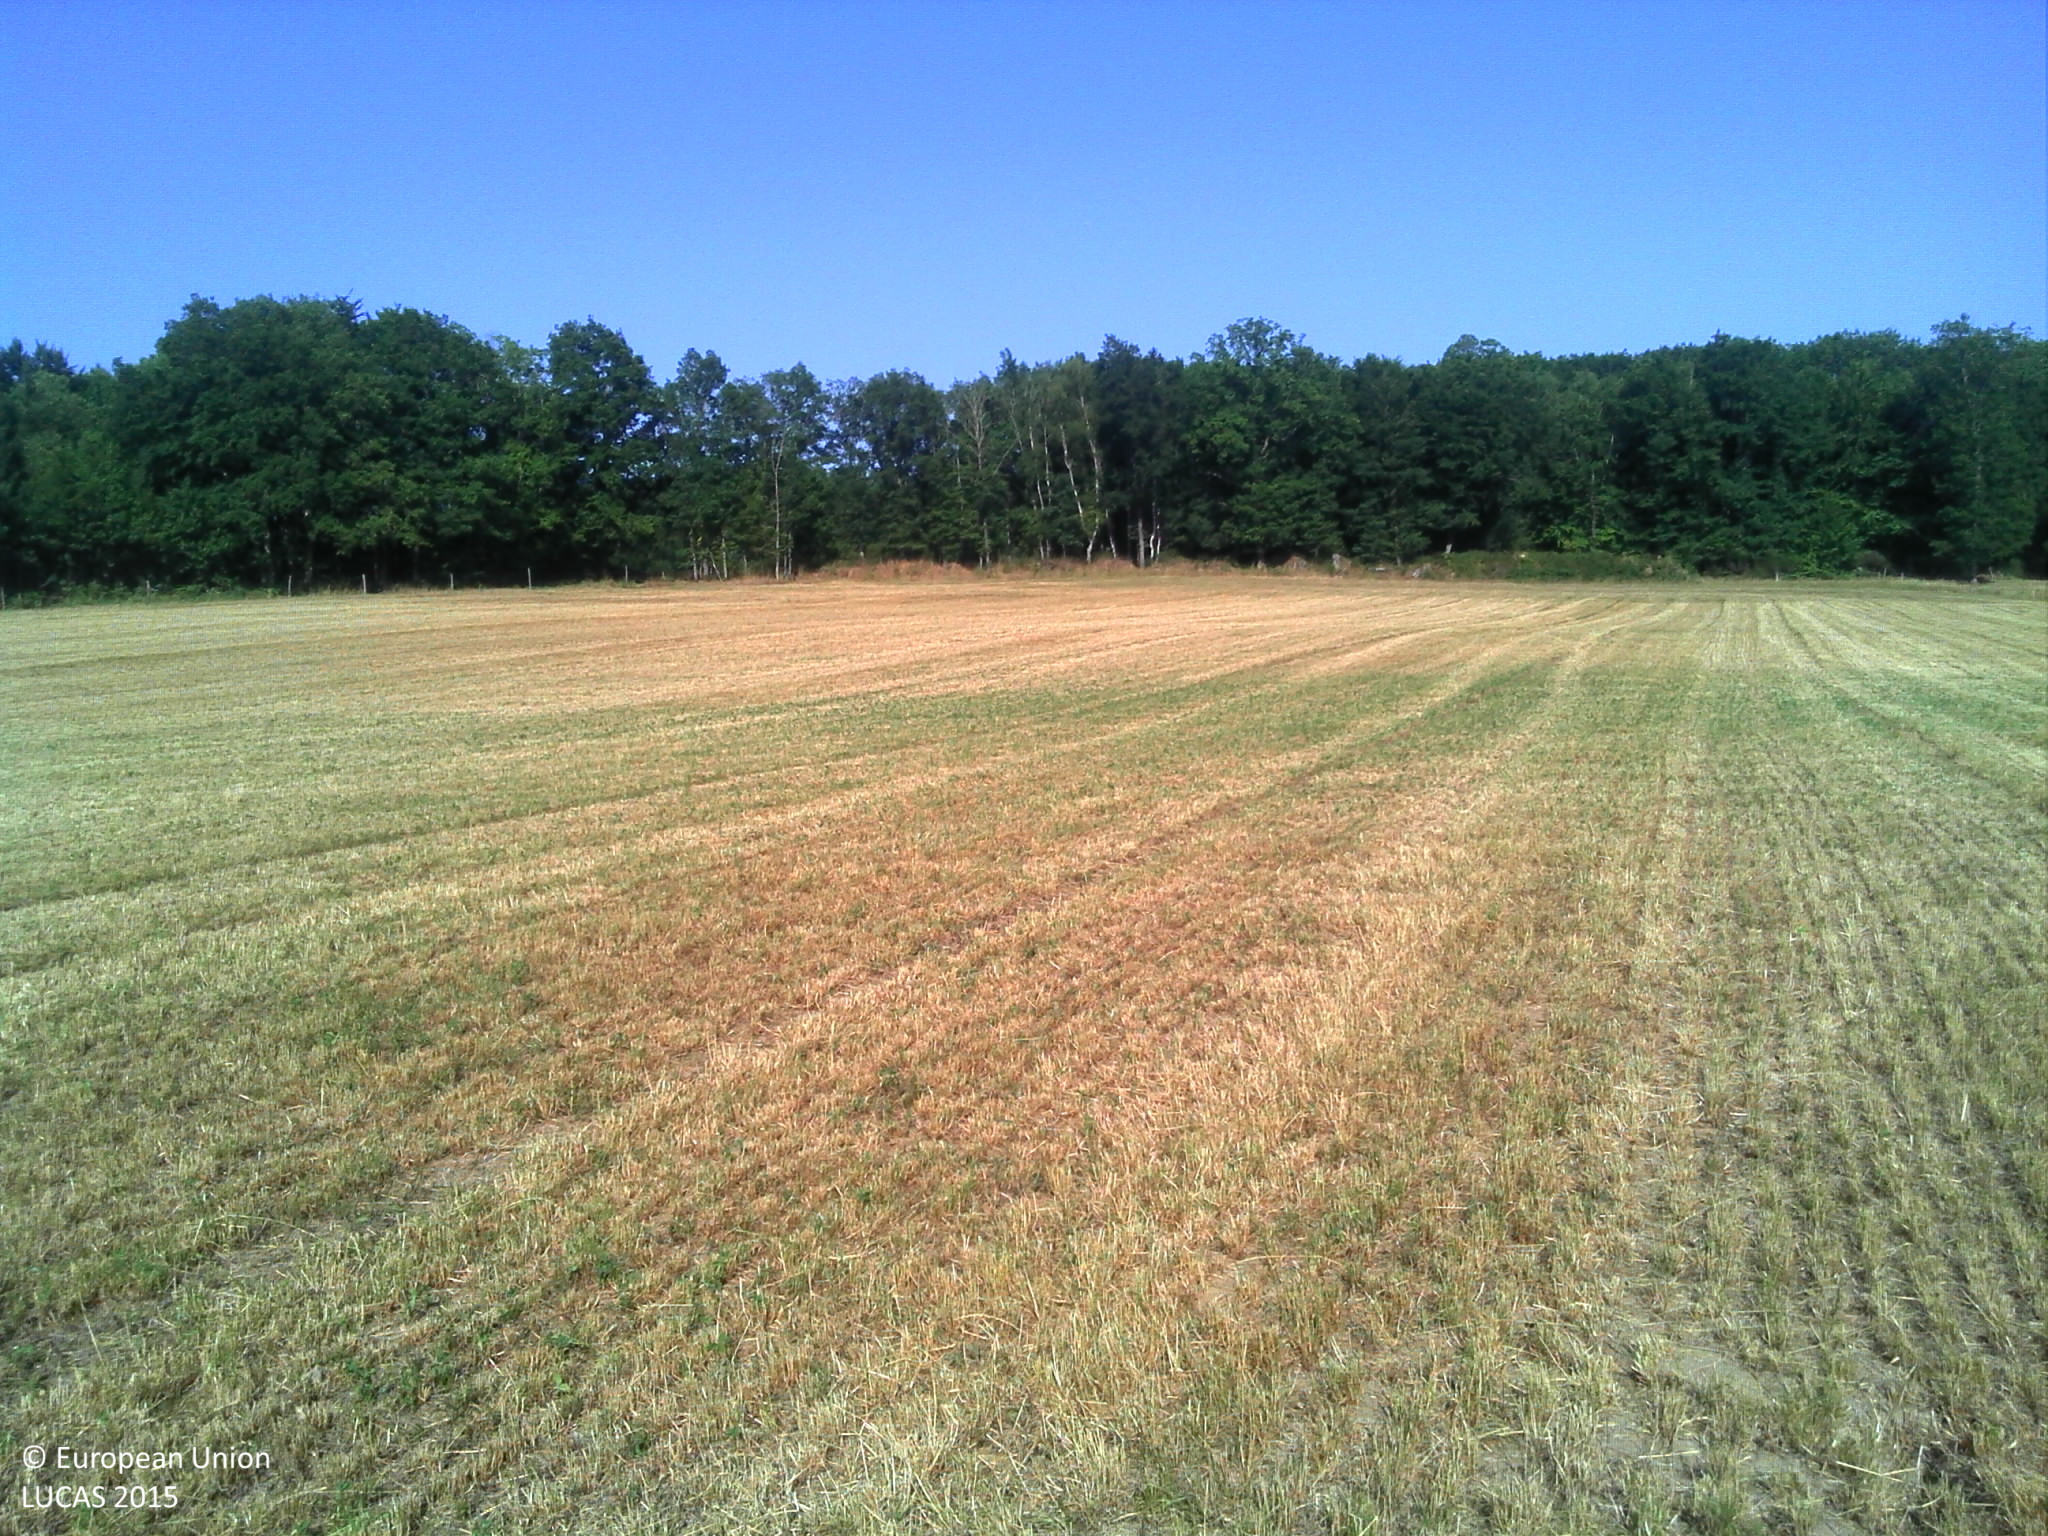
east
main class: Grassland
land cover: Grassland without tree/shrub cover
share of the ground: > 75 %
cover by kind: herbaceous plants 100 %
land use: Agriculture (excluding fallow land and kitchen gardens)
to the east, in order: Grassland without tree/shrub cover; Broadleaved woodland; Fences; Tracks; Broadleaved woodland; Tracks; Broadleaved woodland
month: July
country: FR
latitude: 46.1226
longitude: 1.7491
